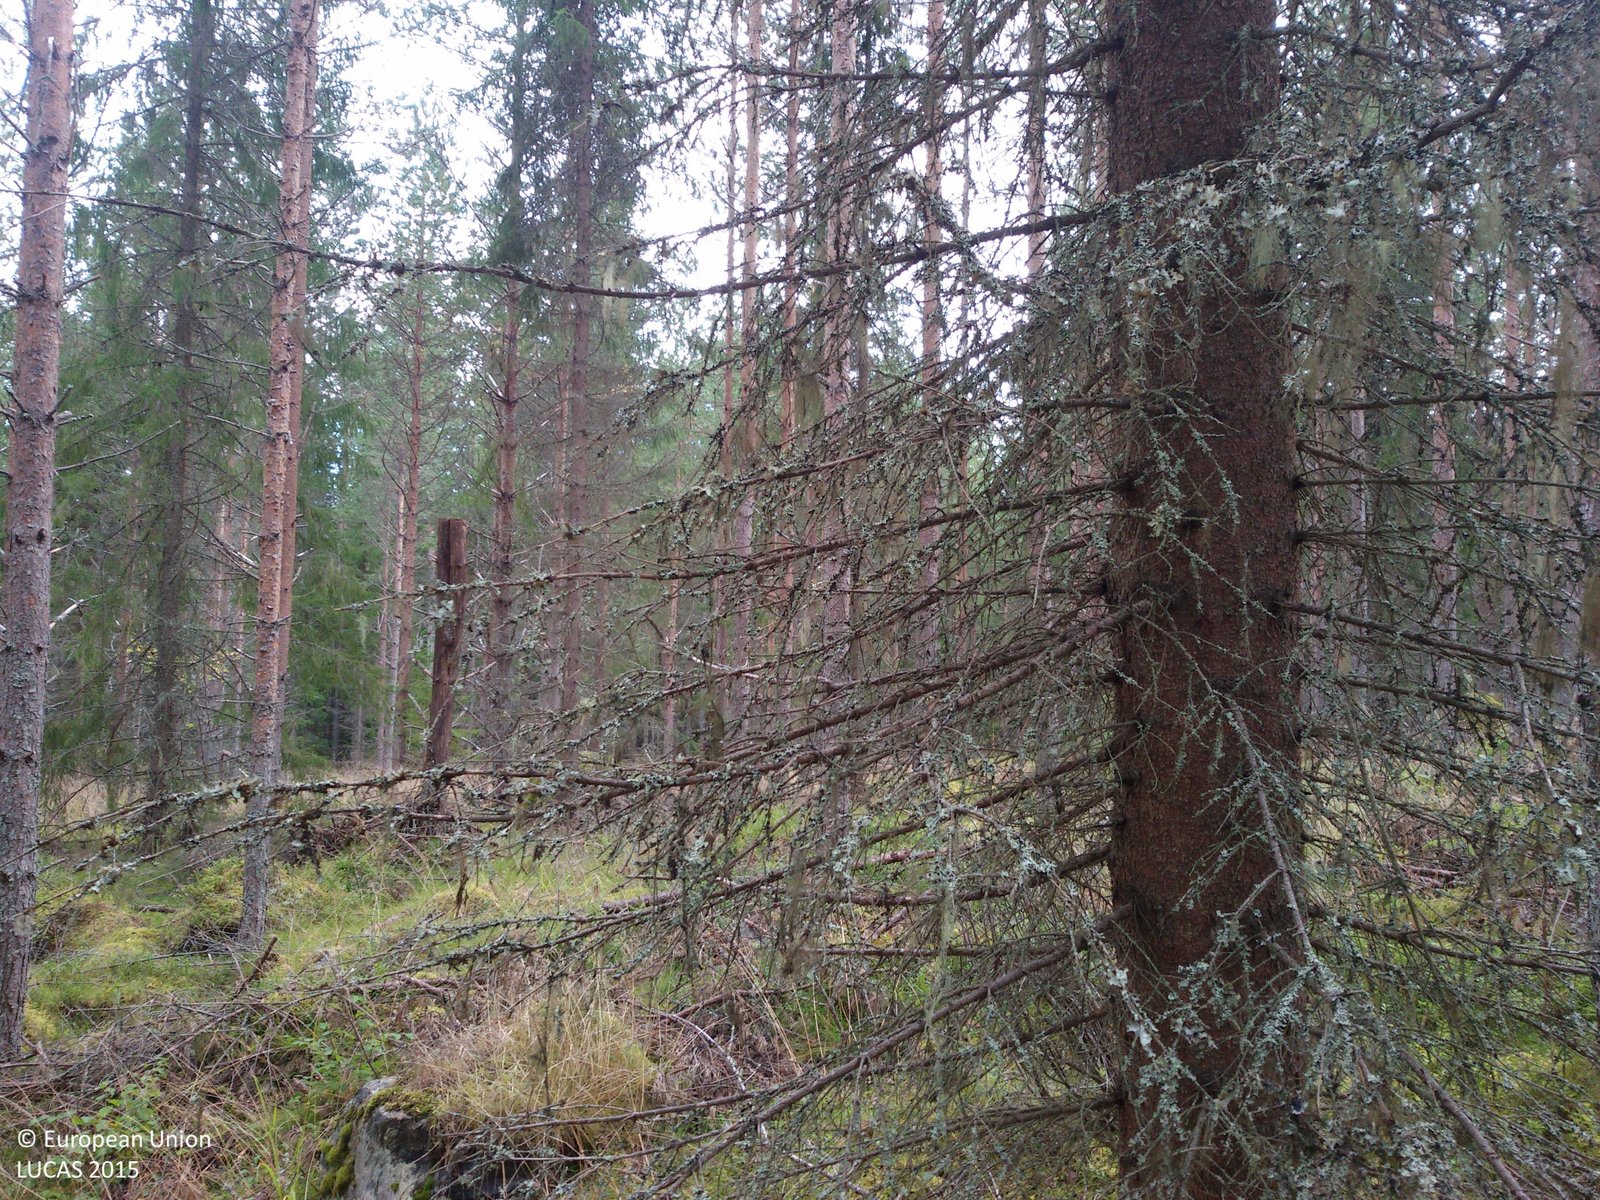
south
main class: Woodland
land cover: Pine dominated coniferous woodland
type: boreal forest
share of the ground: 50 - 75 %
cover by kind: coniferous forest trees 70 %, lichens and mosses 20 %, herbaceous plants 10 %
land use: Forestry
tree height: > 5 m
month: September
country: SE
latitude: 60.6928
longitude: 15.3531
